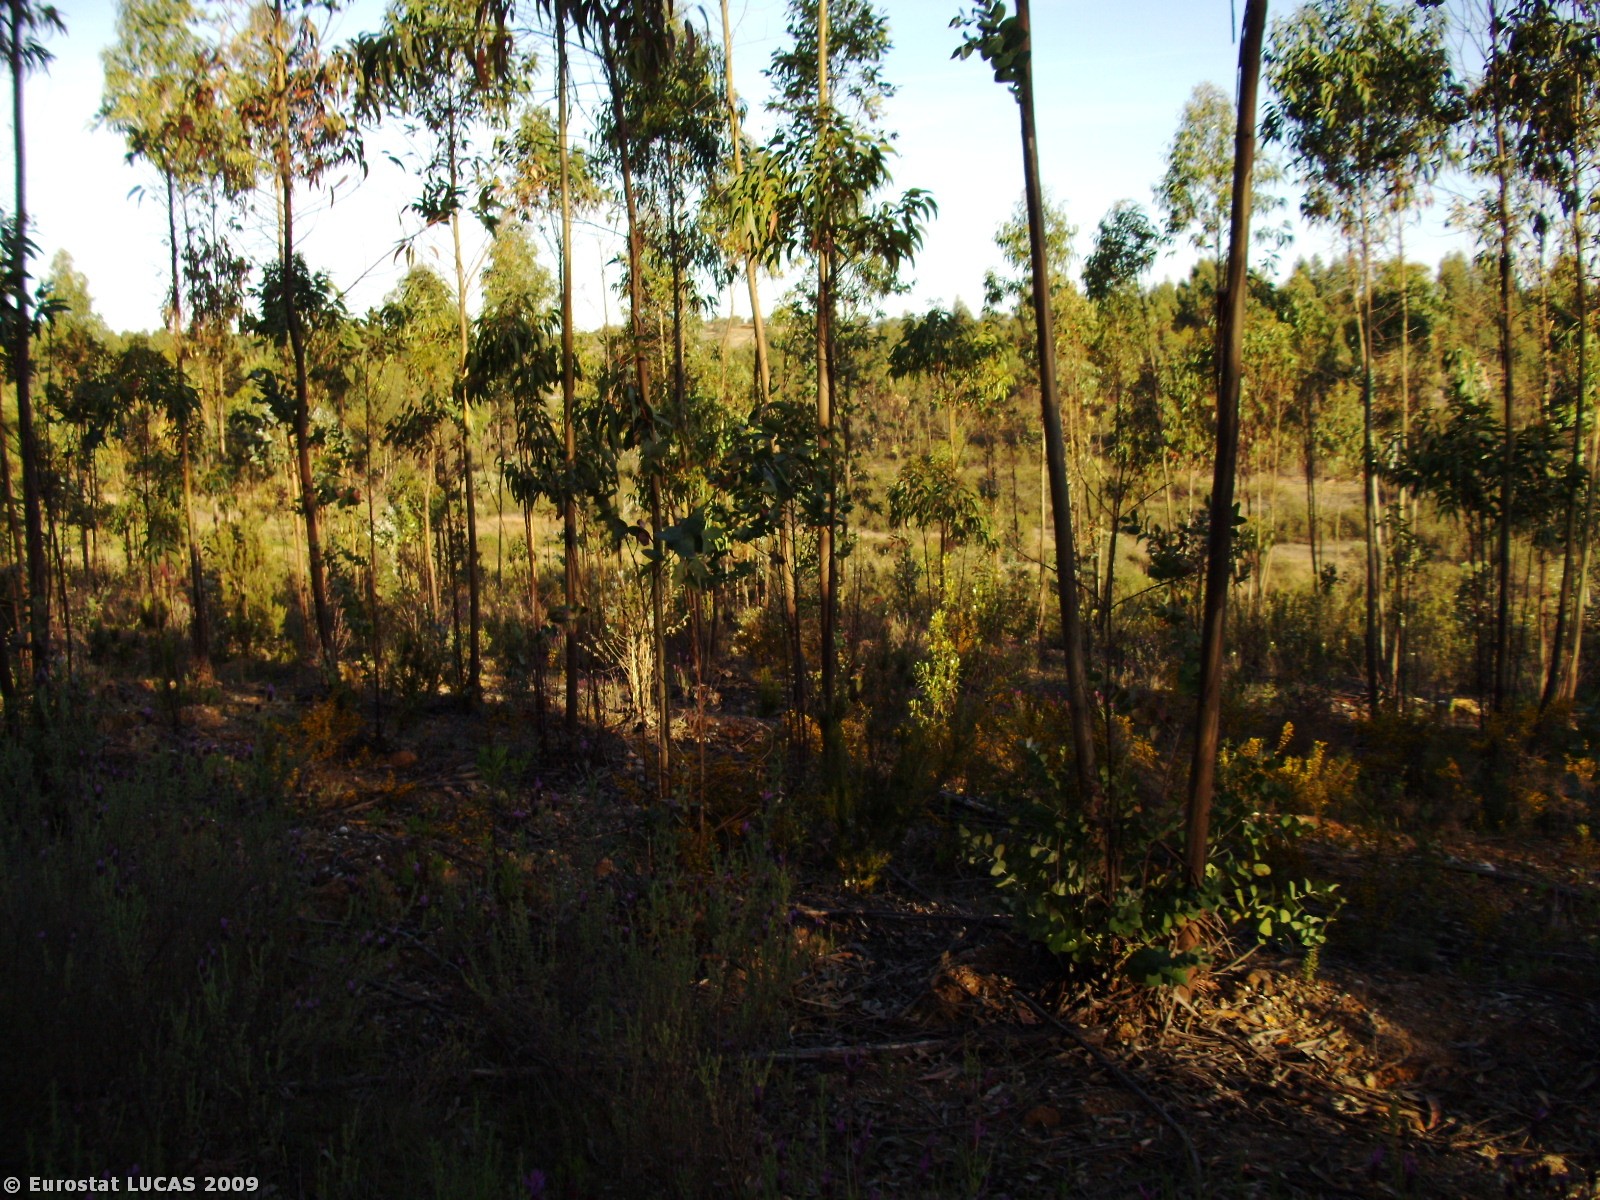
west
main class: Woodland
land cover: Broadleaved woodland
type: plantations and self-sown exotic forest
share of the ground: > 75 %
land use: Forestry
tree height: > 5 m
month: May
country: PT
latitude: 39.6862
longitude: -7.5532
